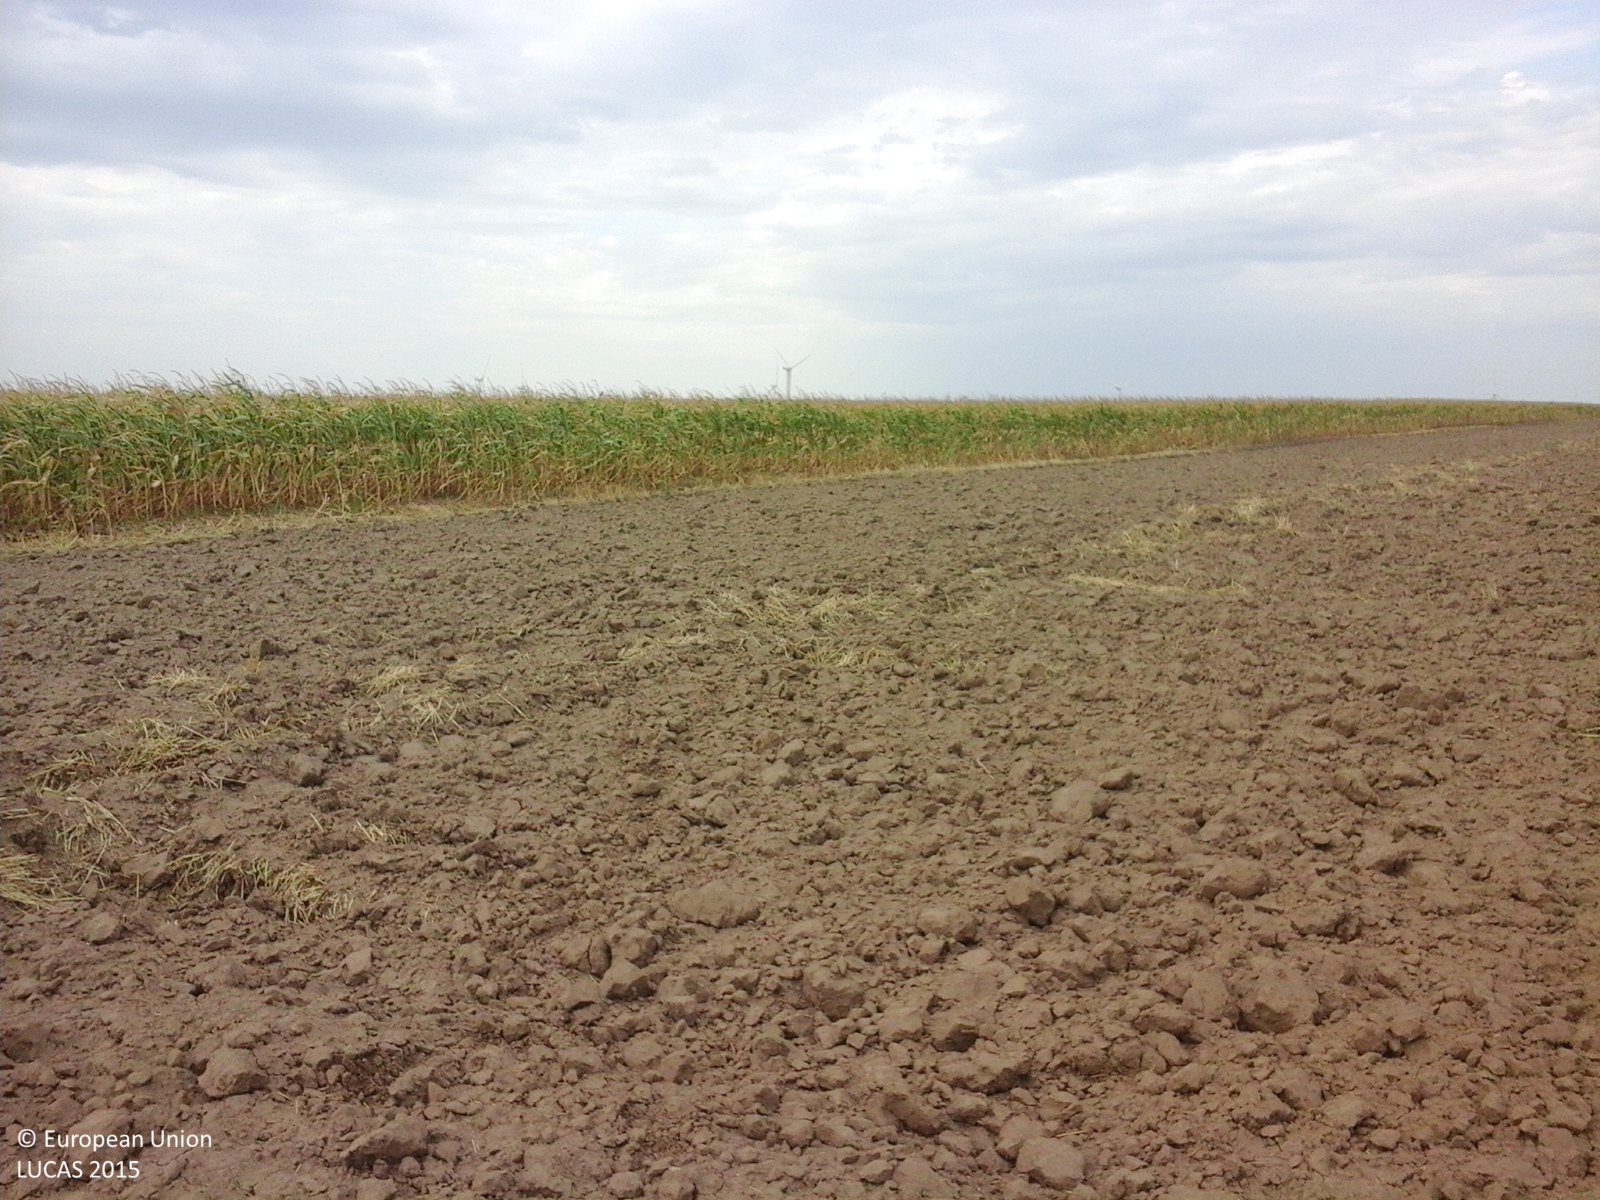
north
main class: Cropland
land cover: Common wheat
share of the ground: < 10 %
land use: Agriculture (excluding fallow land and kitchen gardens)
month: August
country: RO
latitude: 44.3545
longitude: 28.1645
